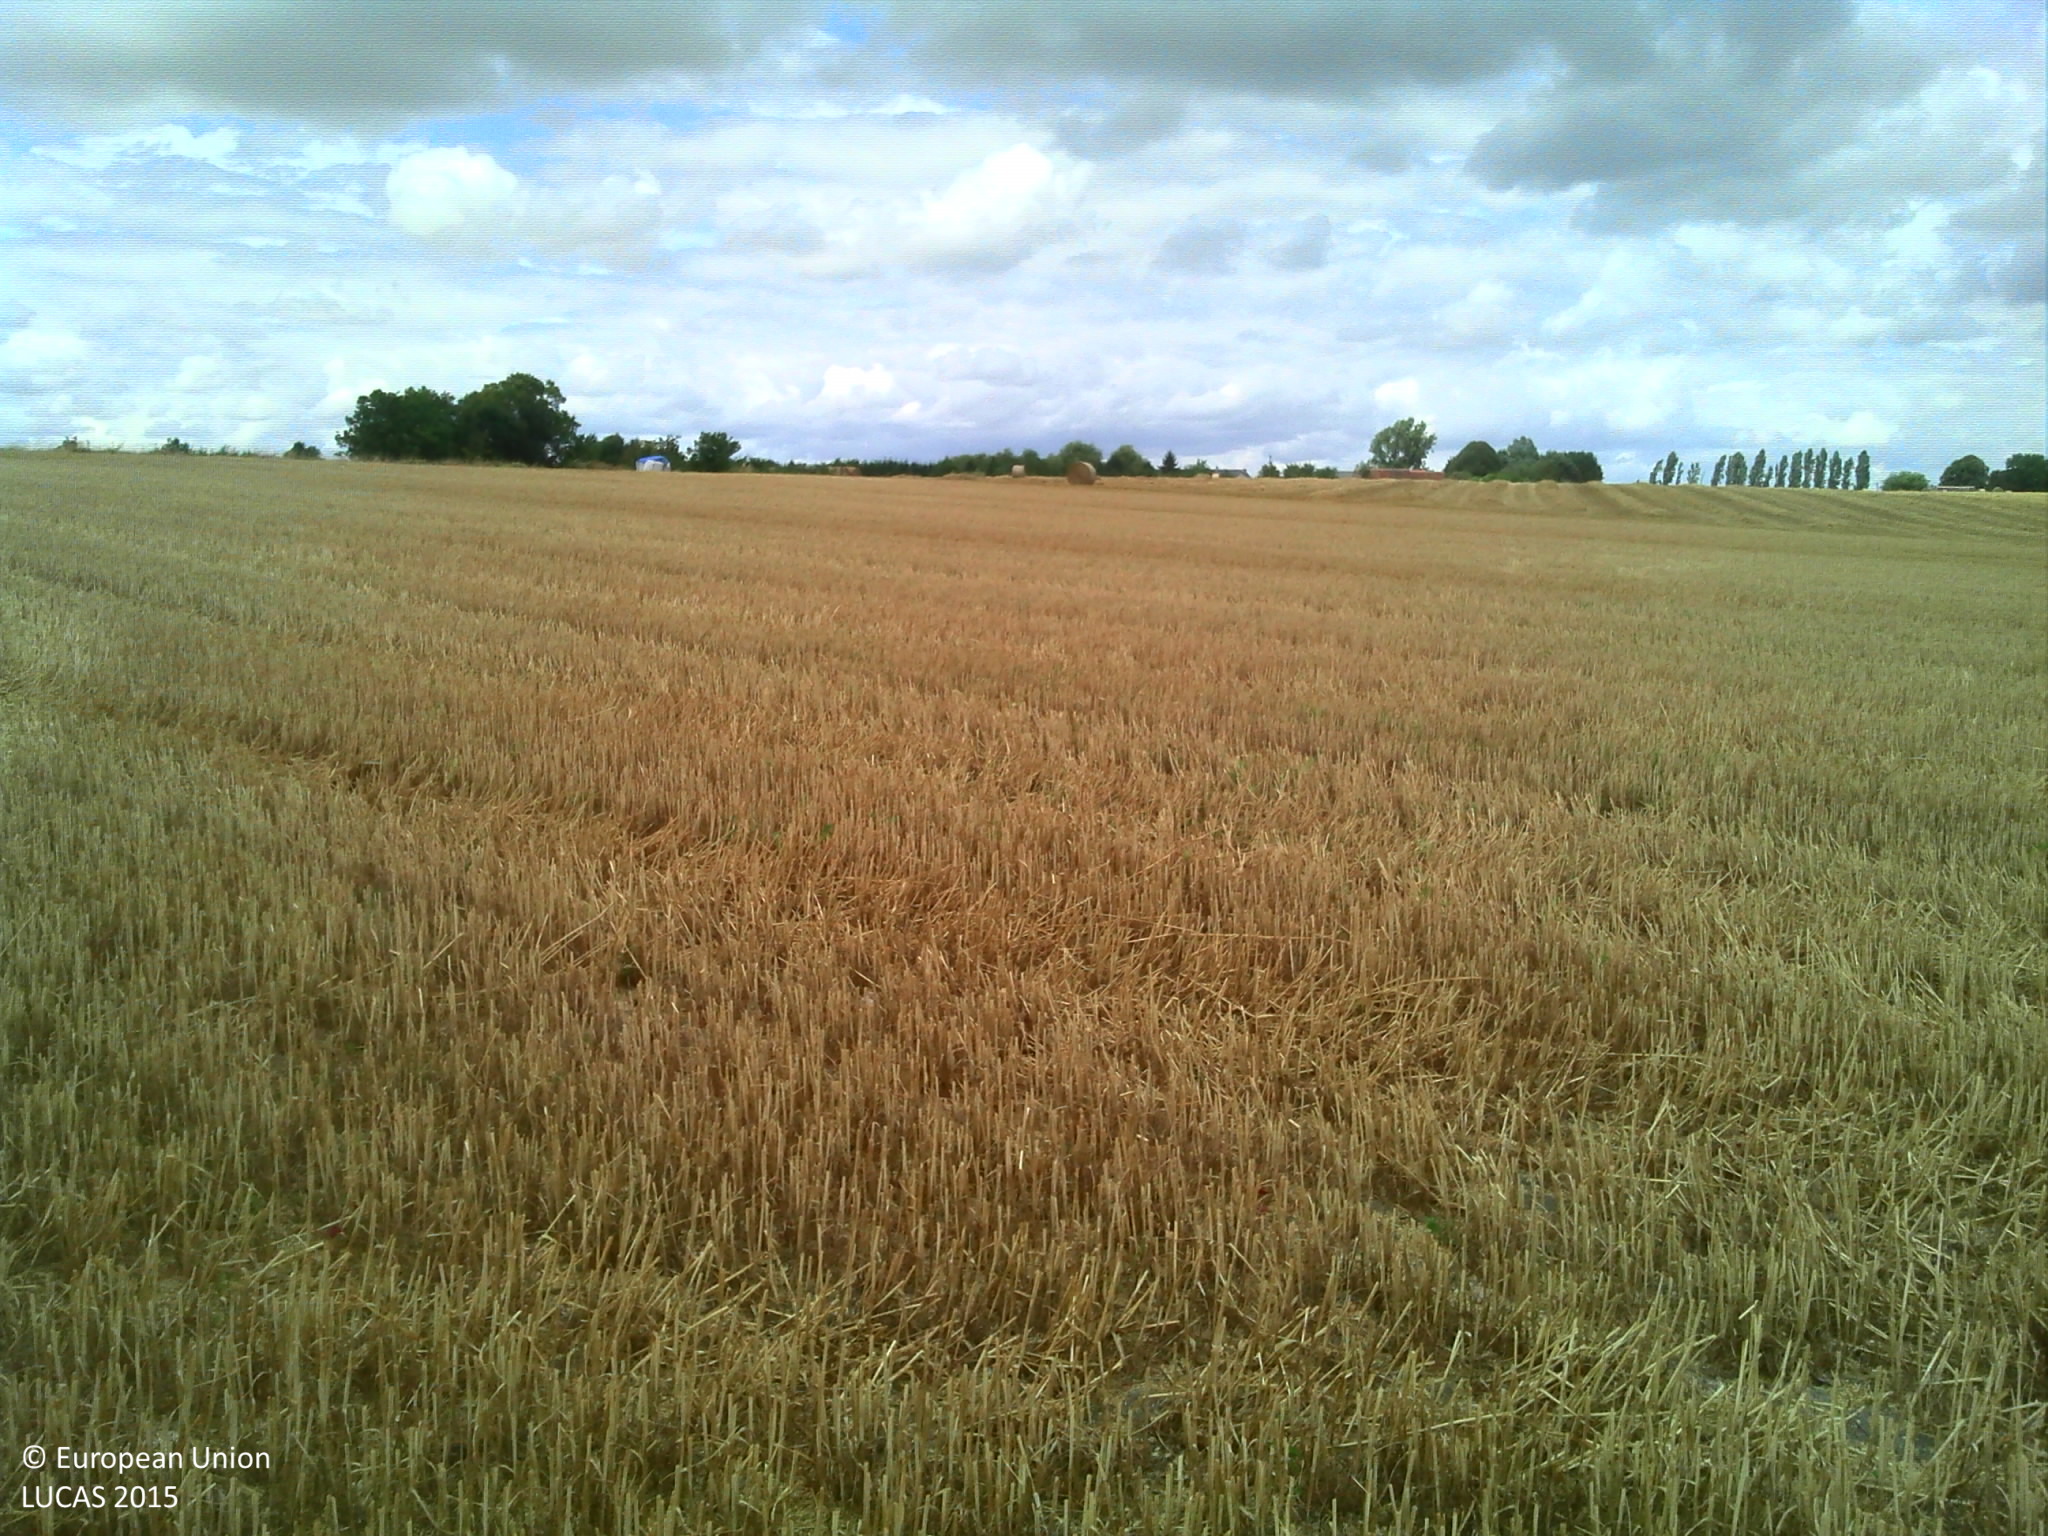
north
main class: Cropland
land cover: Common wheat
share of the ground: > 75 %
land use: Agriculture (excluding fallow land and kitchen gardens)
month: July
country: FR
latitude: 46.9862
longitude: 0.7926
